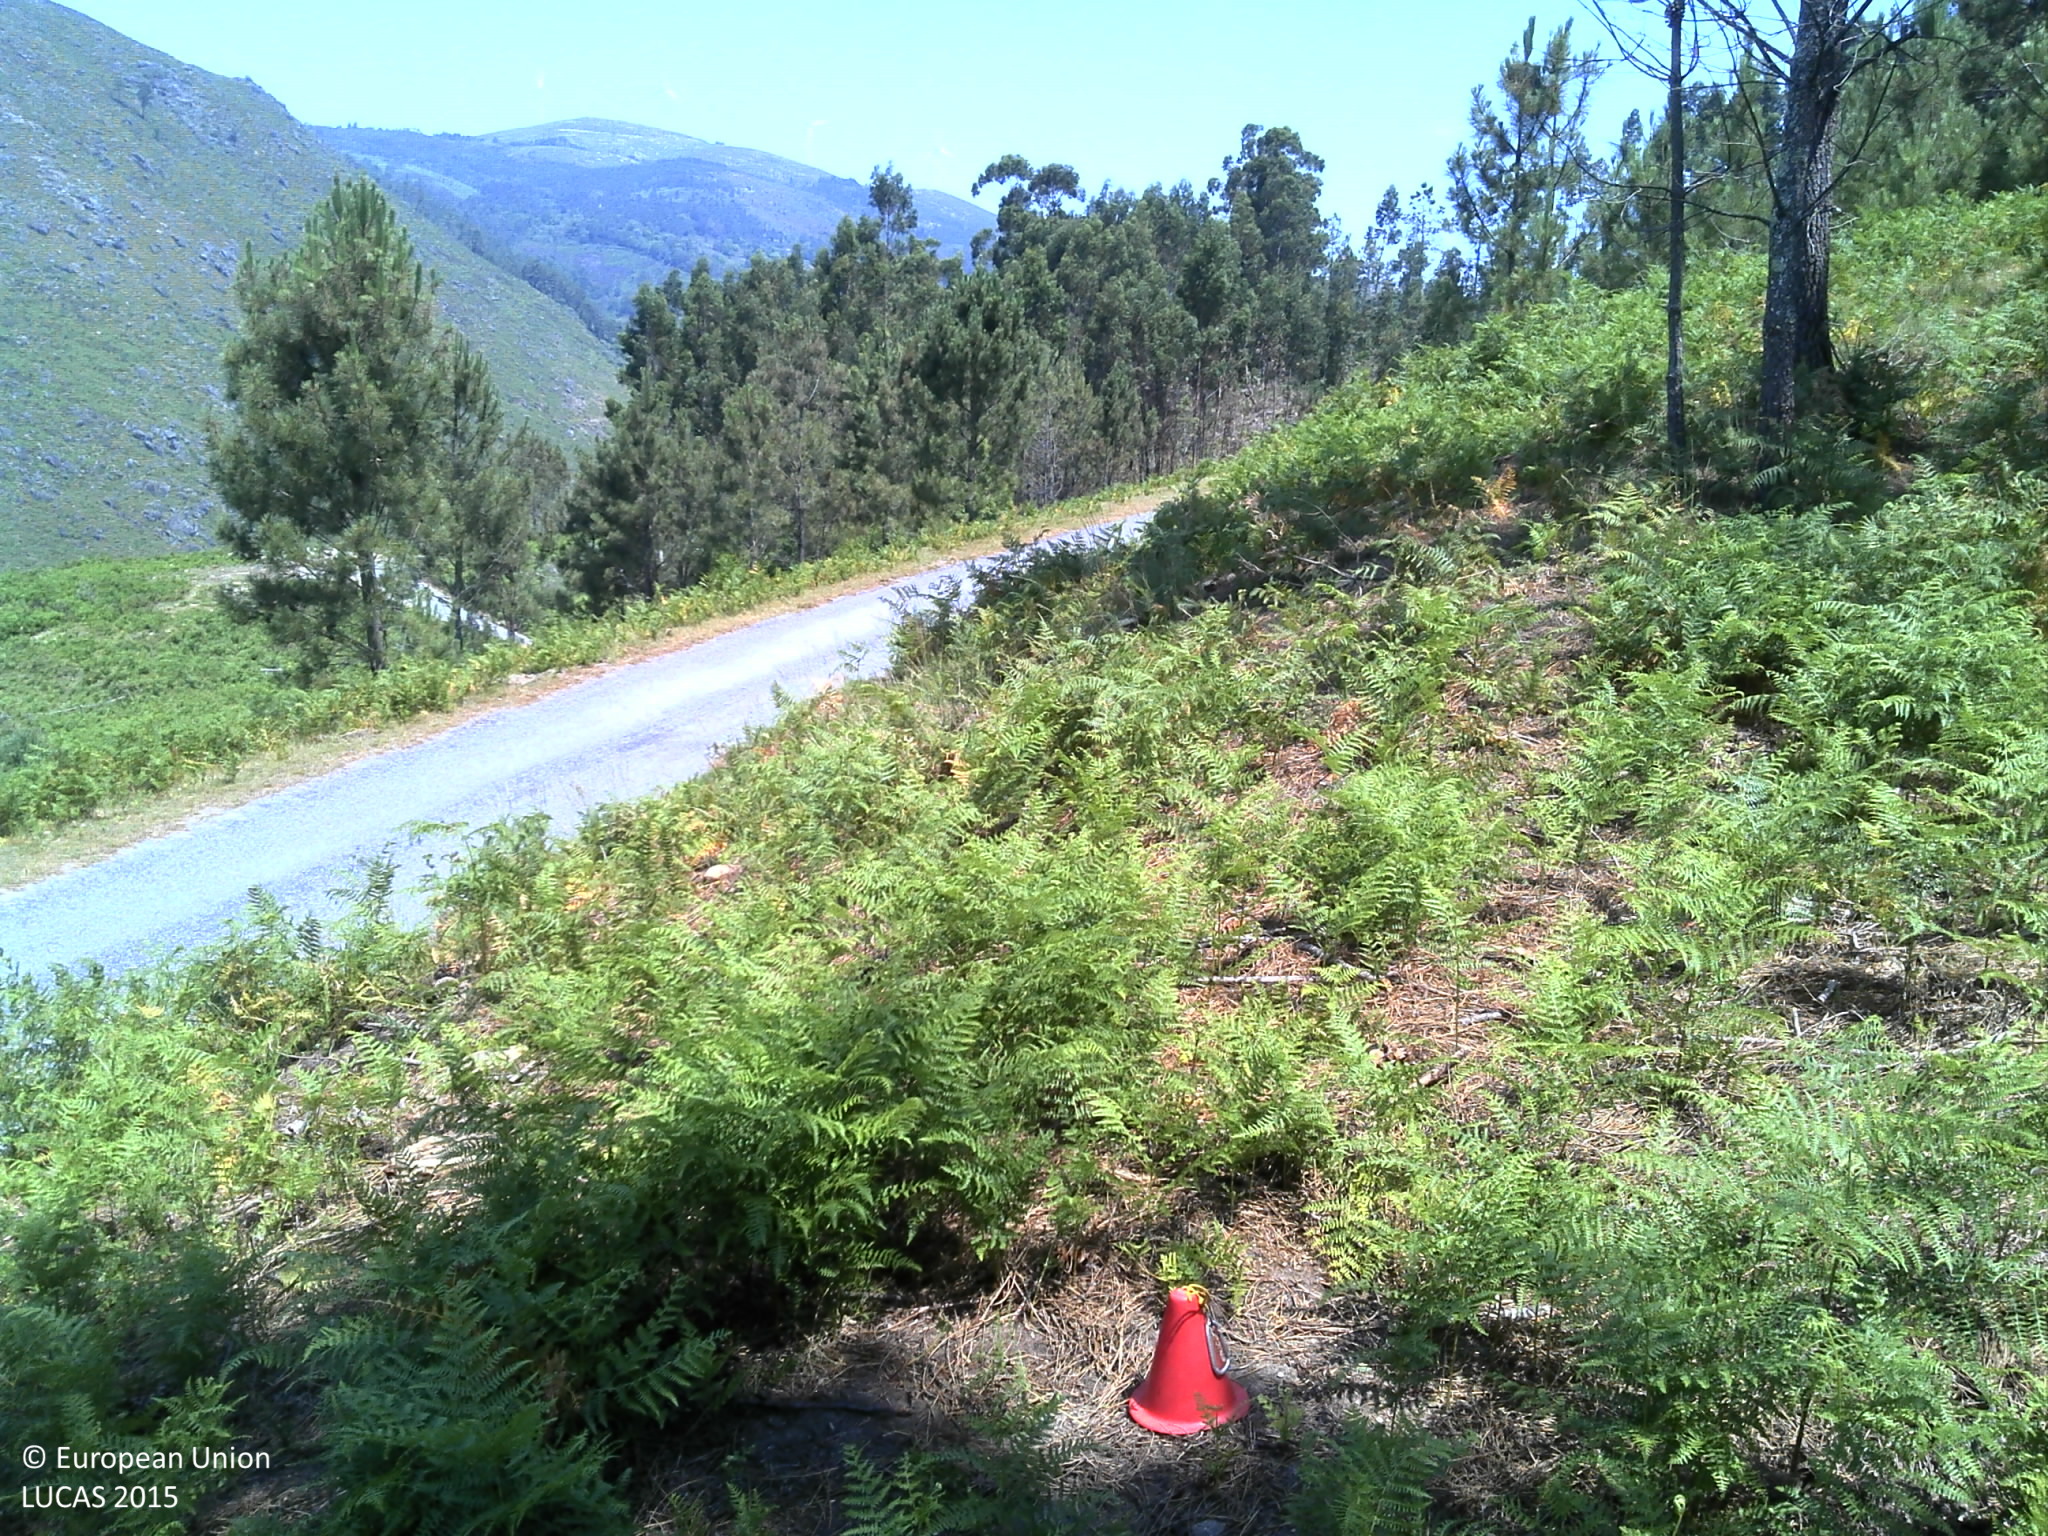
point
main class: Woodland
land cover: Pine dominated coniferous woodland
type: coniferous forest of the mediterranean region
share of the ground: 25 - 50 %
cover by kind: coniferous forest trees 50 %, consolidated bare surface 30 %, shrubs 20 %
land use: Forestry
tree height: > 5 m
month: June
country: PT
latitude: 41.9467
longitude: -8.4108
